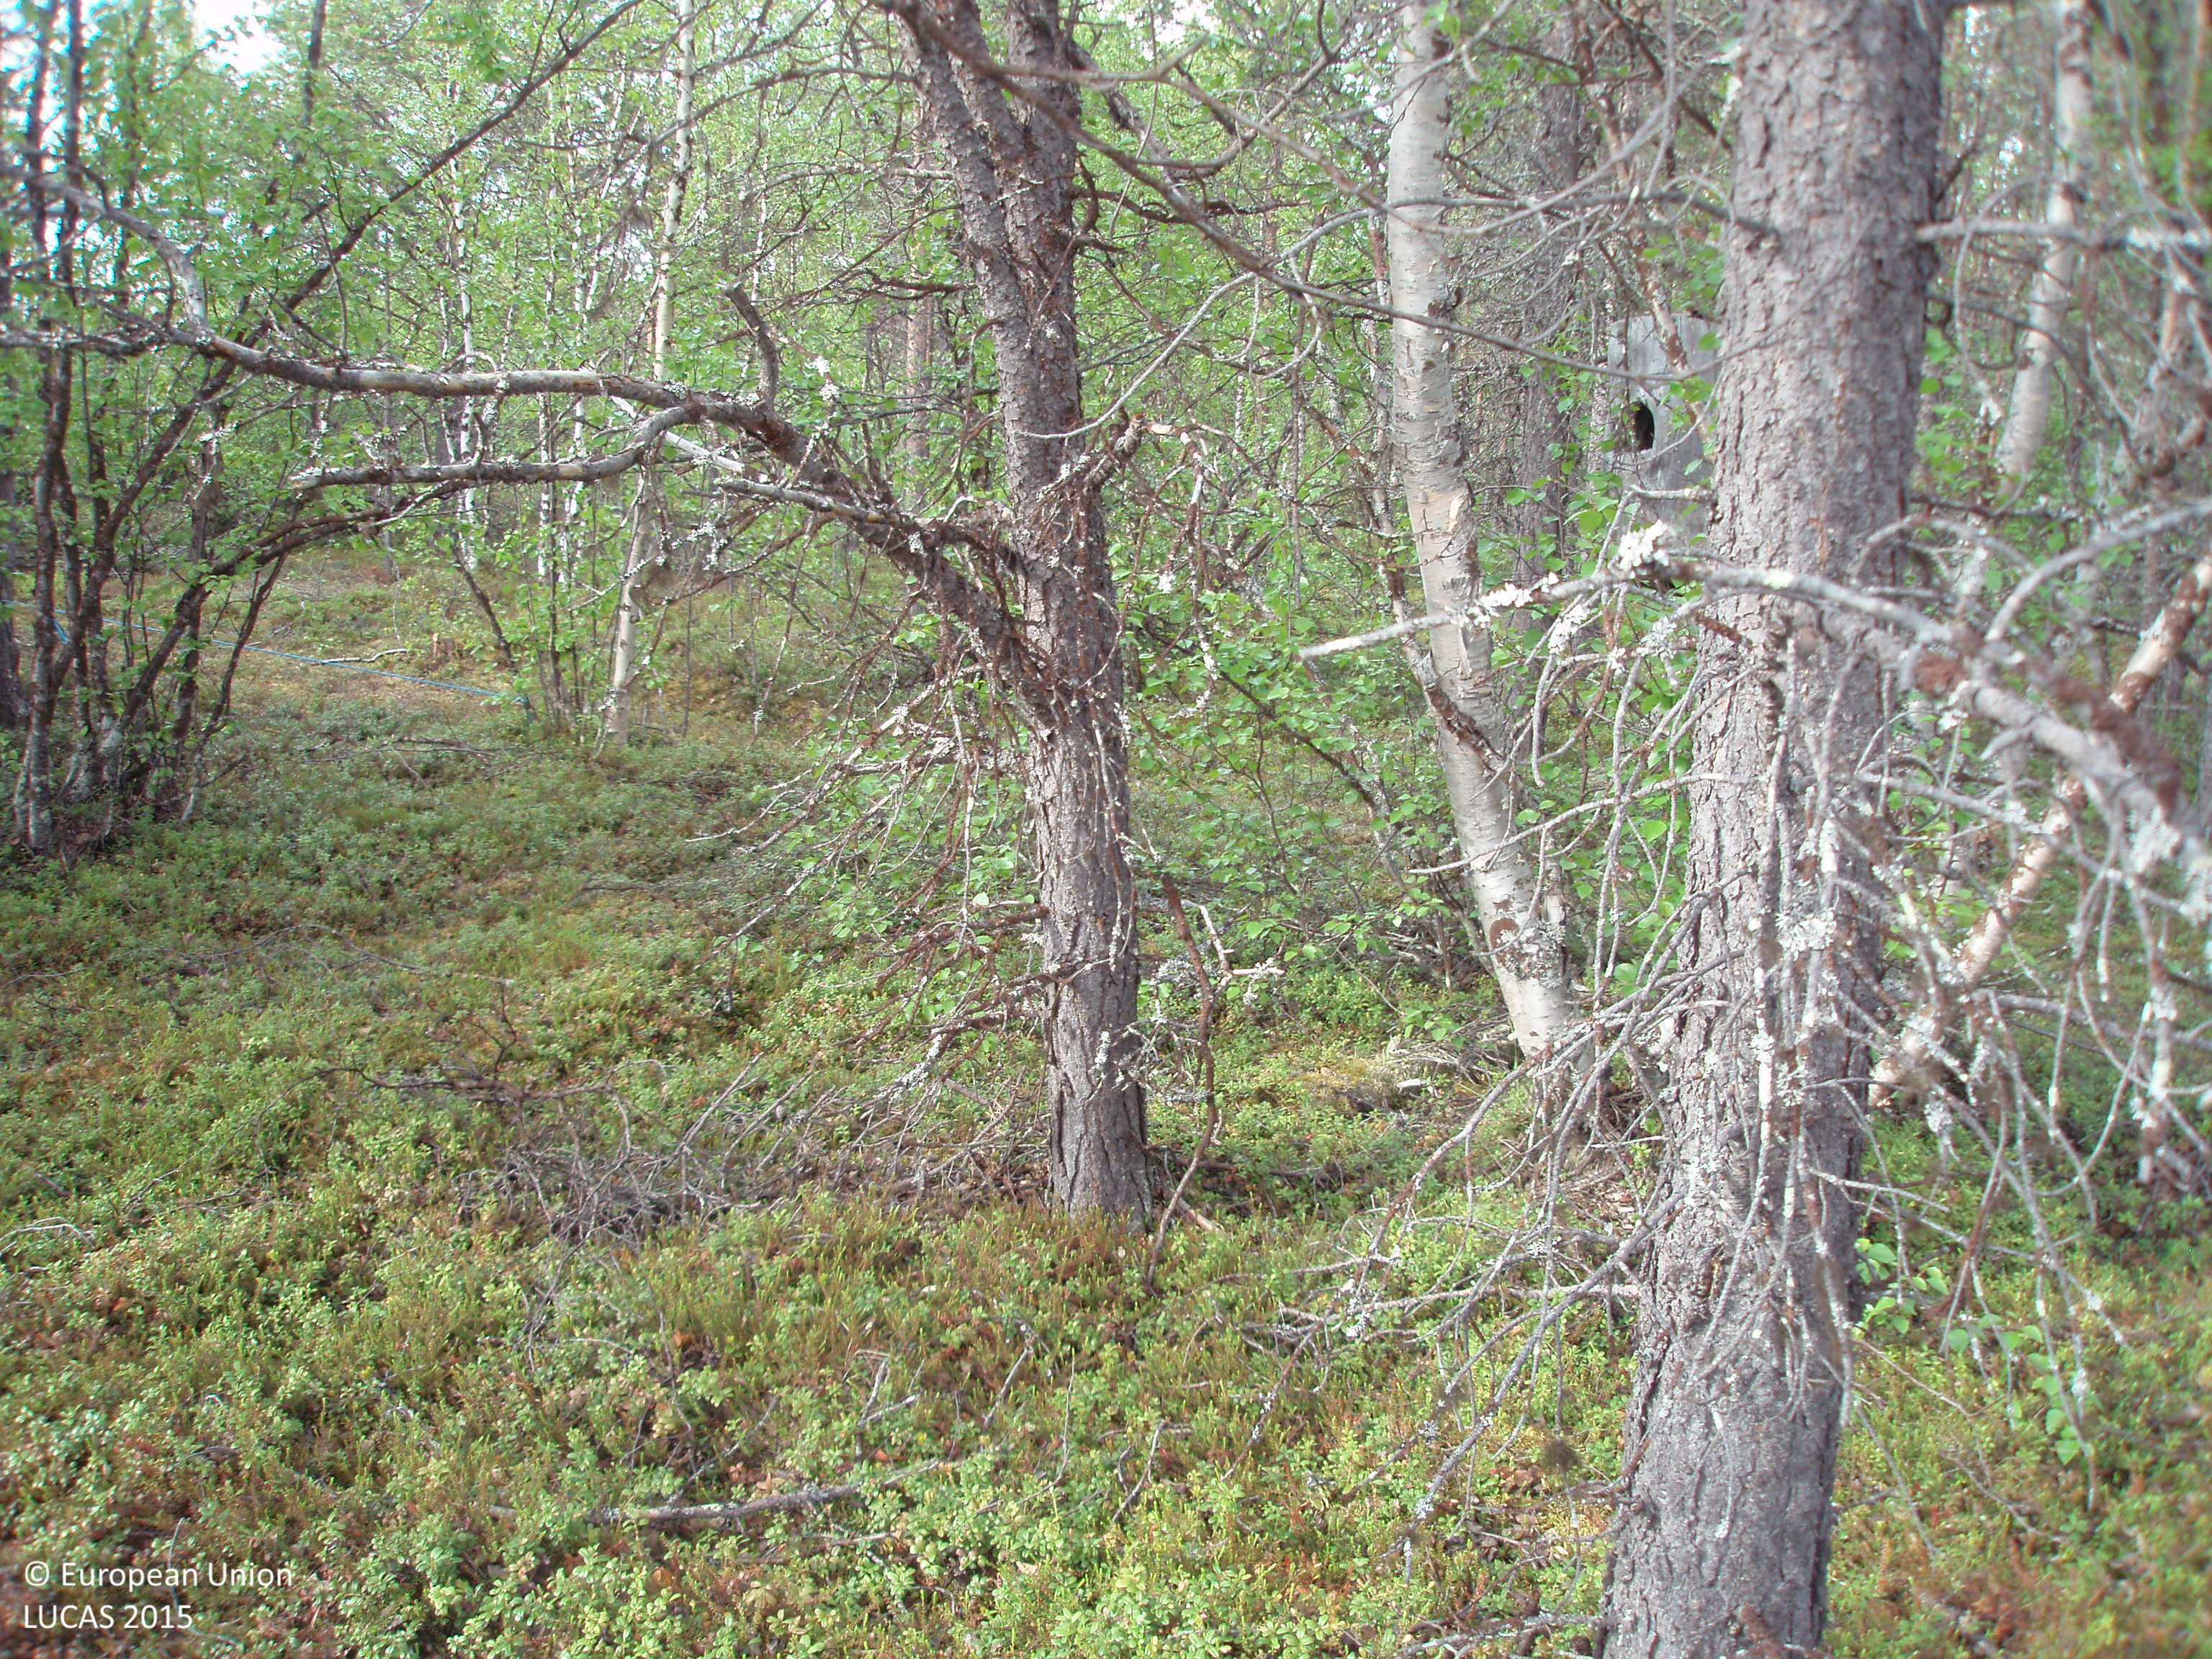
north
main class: Woodland
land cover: Pine dominated mixed woodland
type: boreal forest
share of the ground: > 75 %
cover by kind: broadleaved forest trees 60 %, coniferous forest trees 30 %, shrubs 10 %
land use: Forestry
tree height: > 5 m
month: July
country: FI
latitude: 69.0612
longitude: 25.7497
